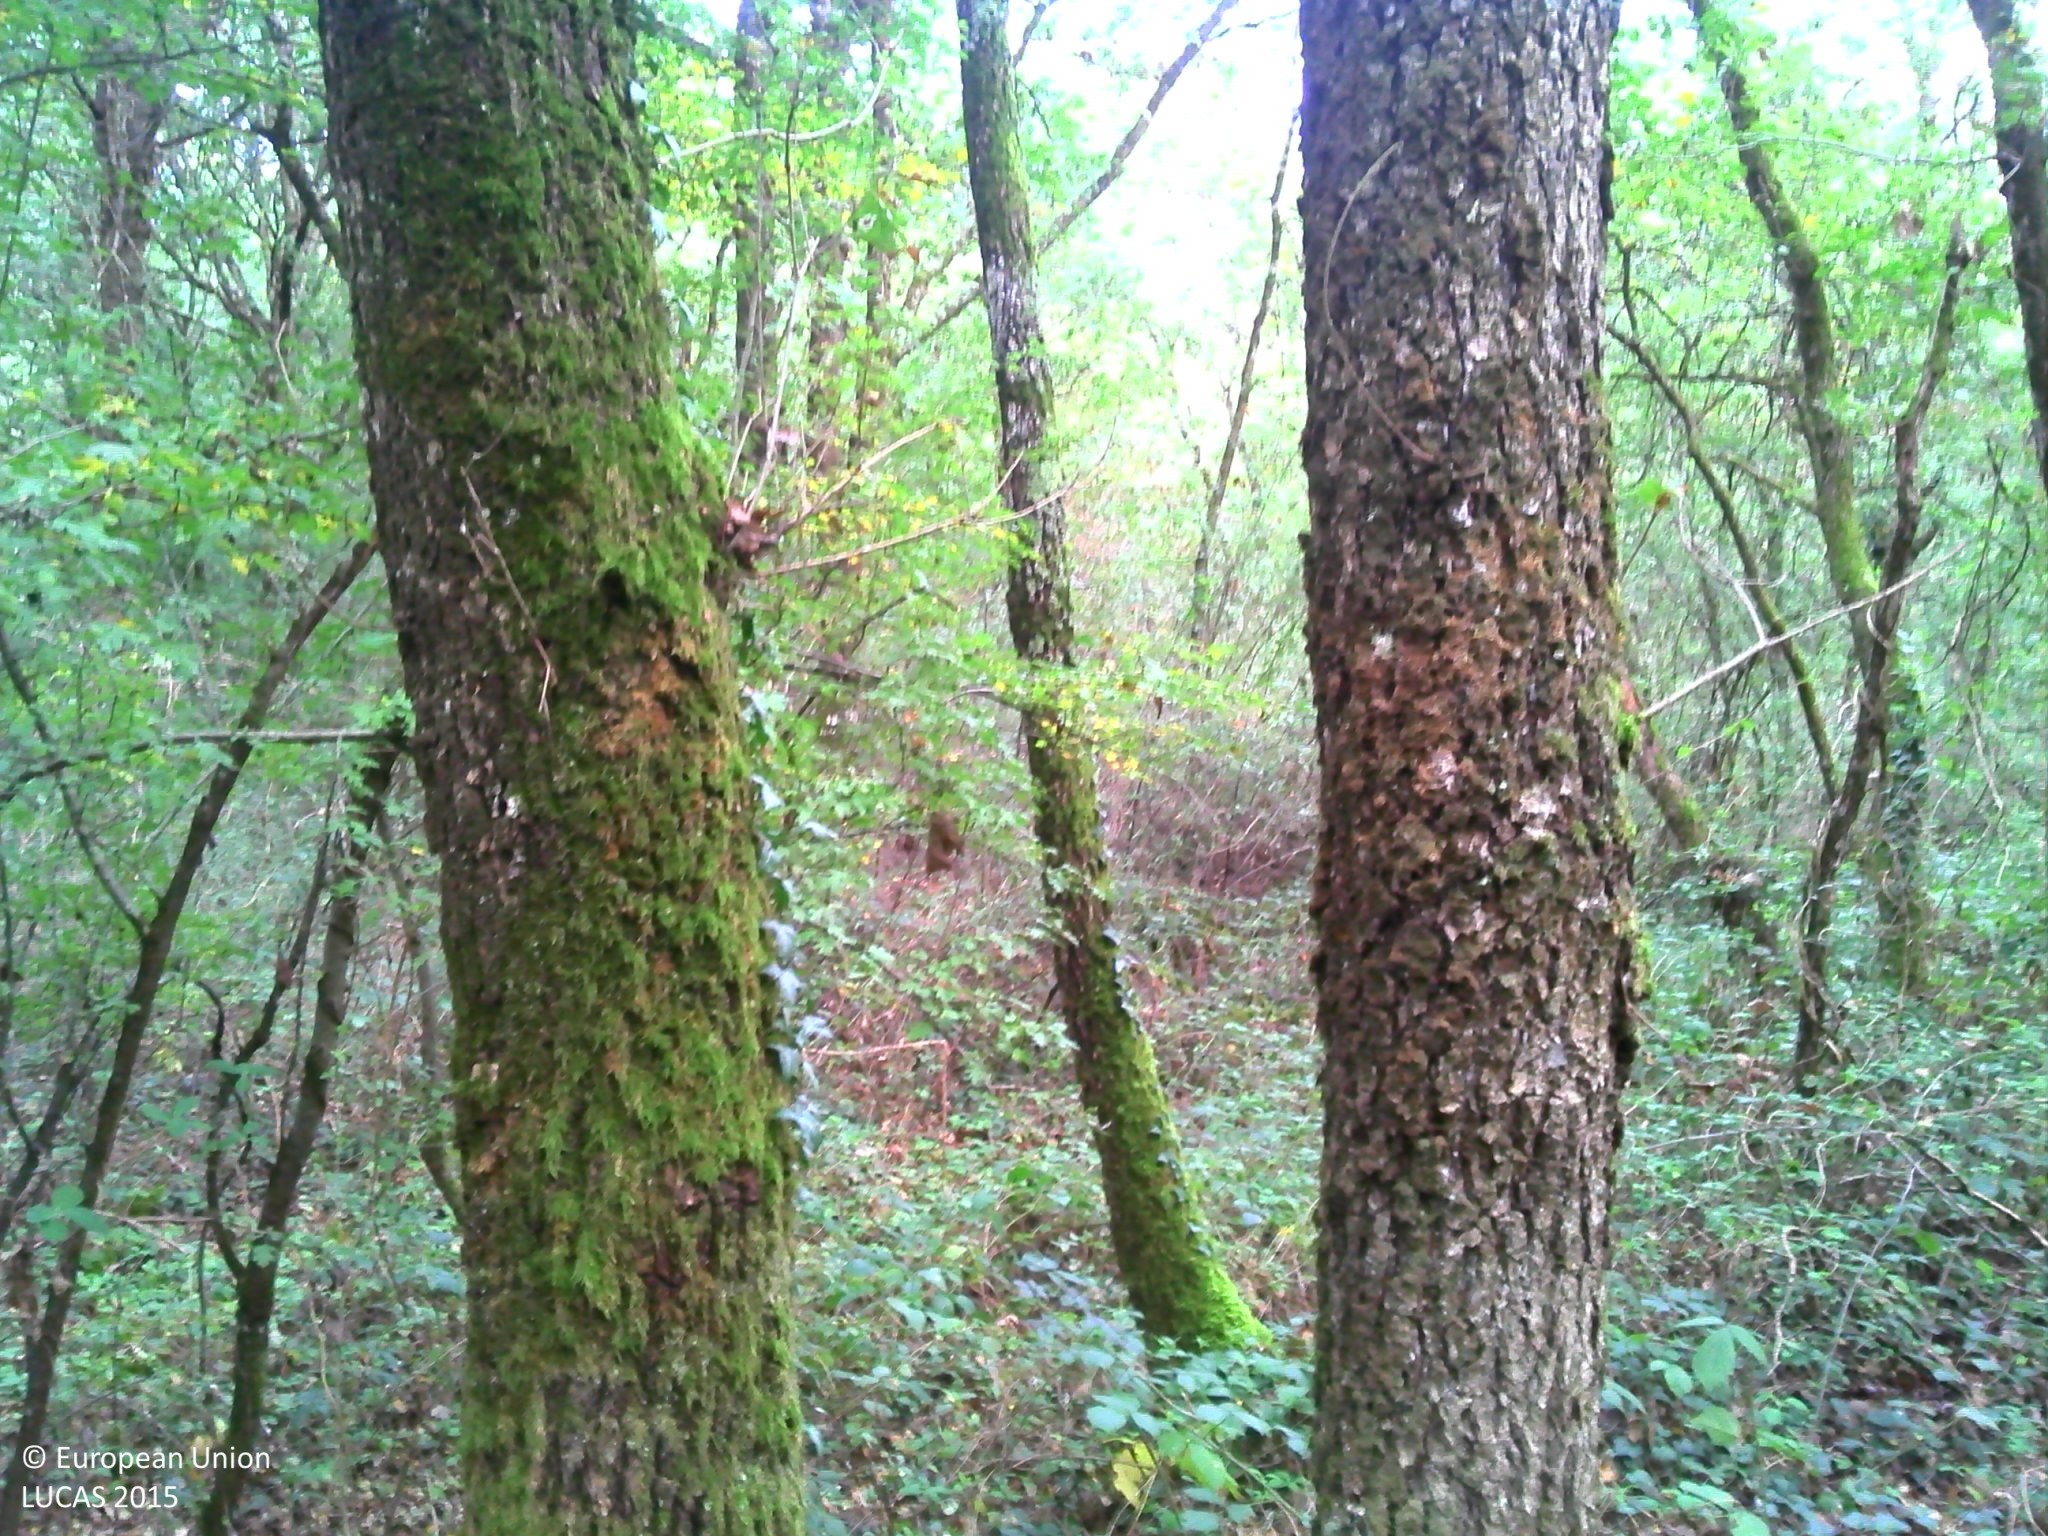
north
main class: Woodland
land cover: Broadleaved woodland
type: mesophytic deciduous forest
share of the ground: > 75 %
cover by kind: broadleaved forest trees 65 %, coniferous forest trees 10 %, shrubs 10 %, herbaceous plants 10 %, lichens and mosses 5 %
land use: Forestry
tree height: > 5 m
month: October
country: FR
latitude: 47.0217
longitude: 0.5742
